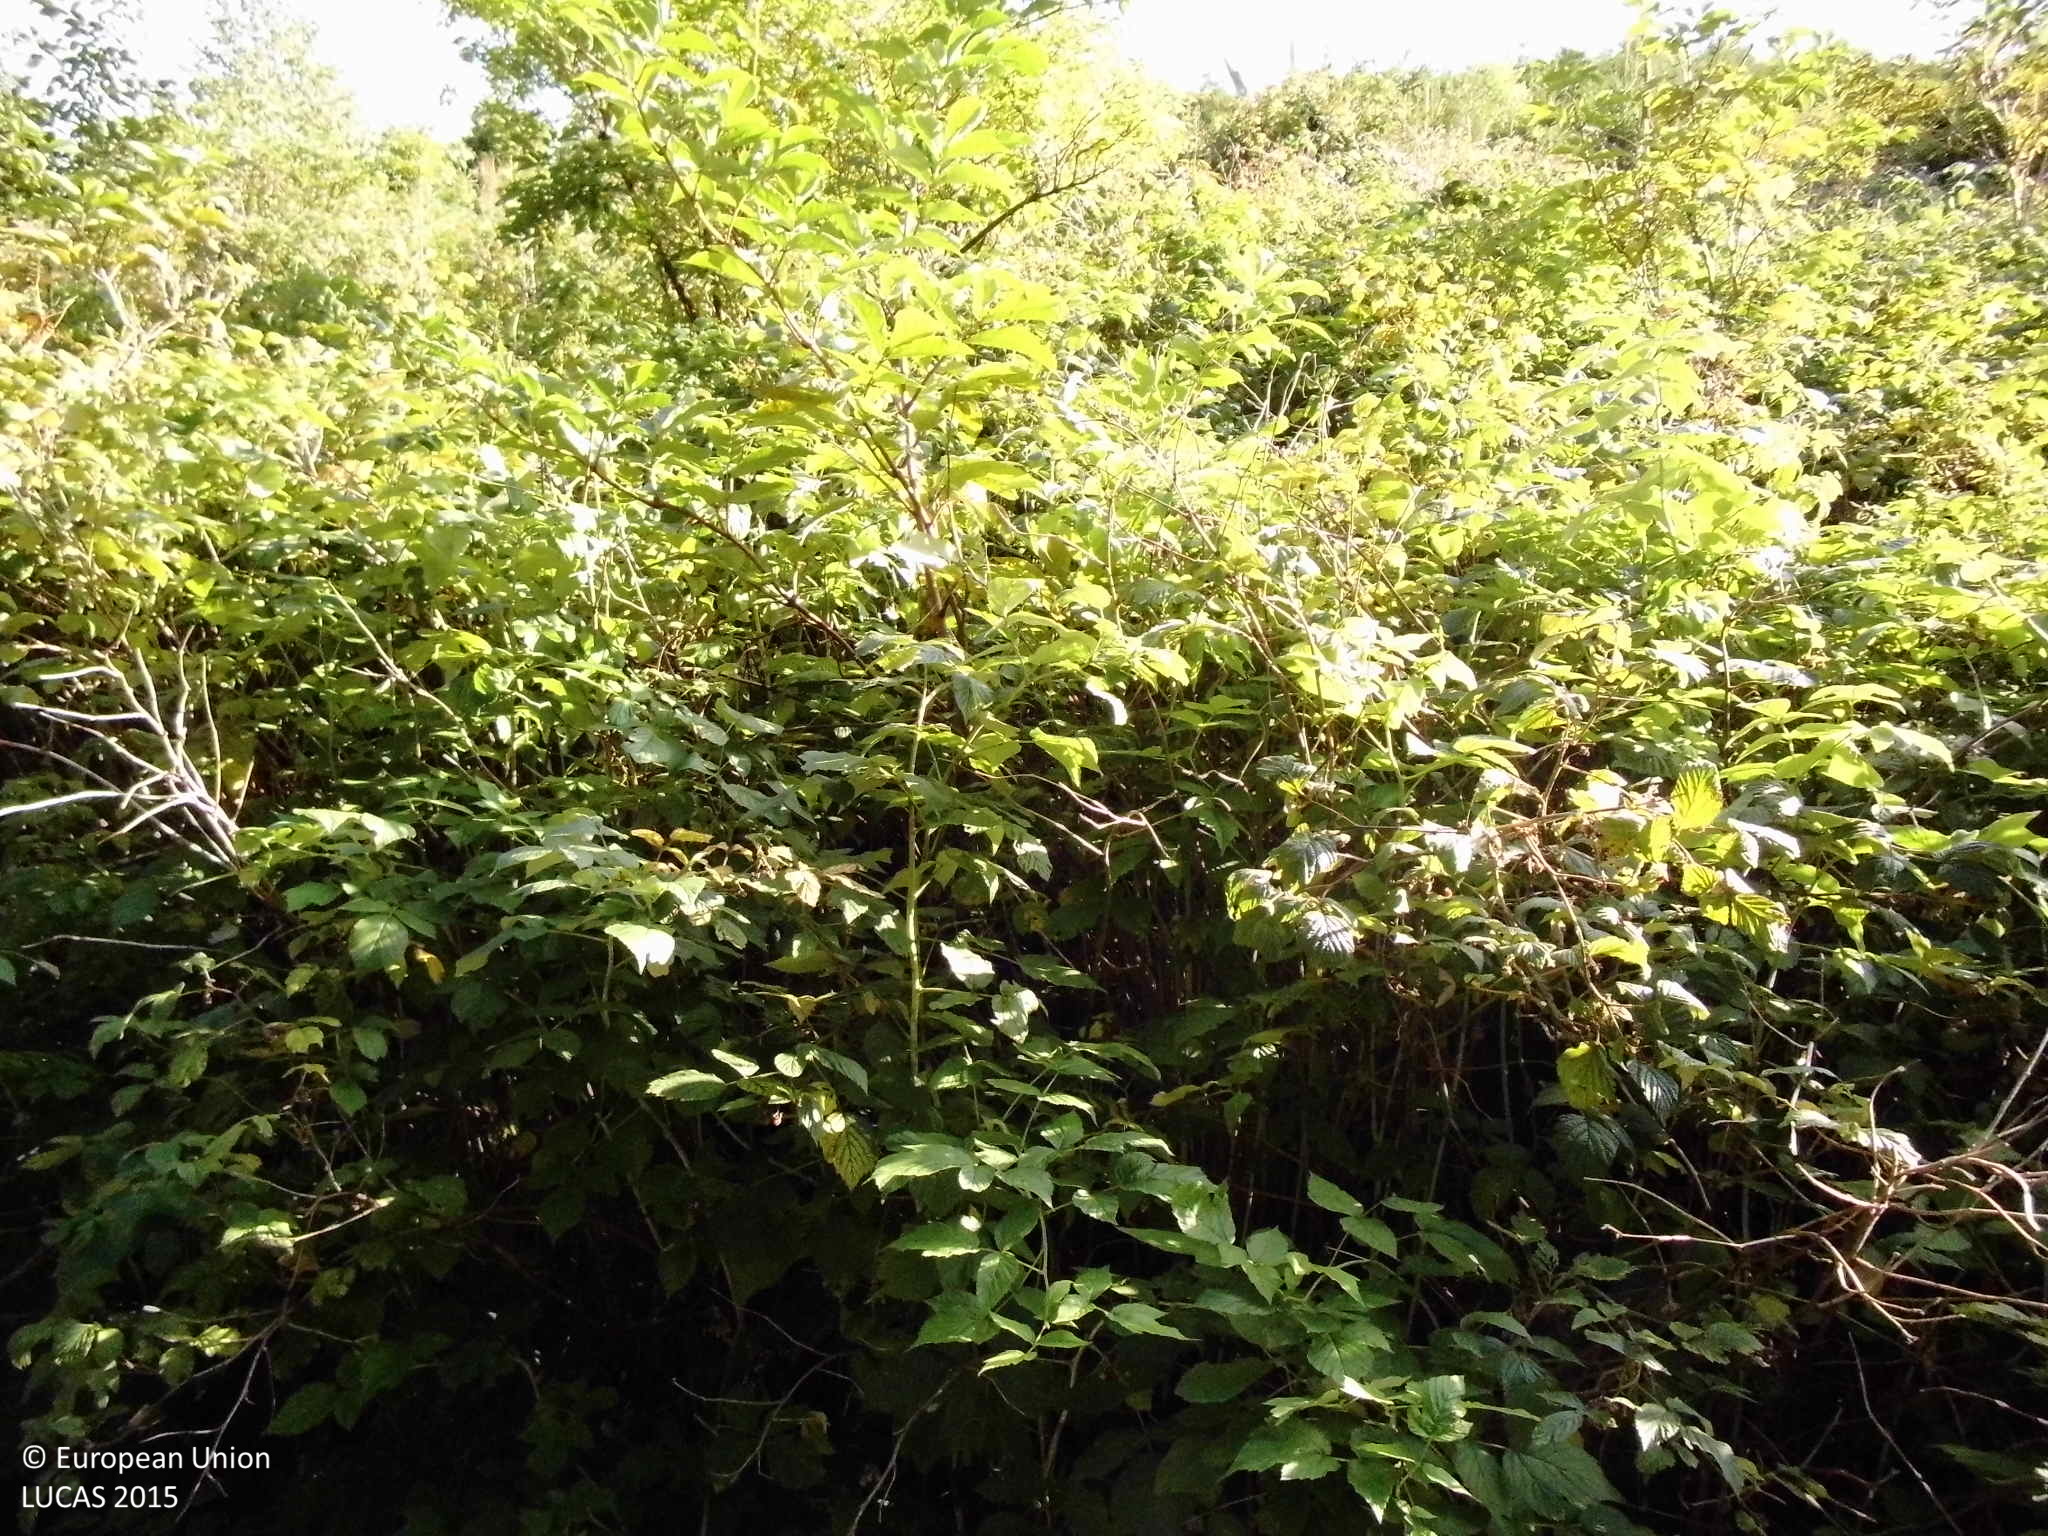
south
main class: Woodland
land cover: Spruce dominated mixed woodland
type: hemiboreal forest and nemoral coniferous forest and mixed broadleaved-coniferous forest
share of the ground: 25 - 50 %
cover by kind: shrubs 50 %, coniferous forest trees 35 %, broadleaved forest trees 15 %
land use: Forestry
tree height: < 5 m
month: September
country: DE
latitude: 51.3083
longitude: 8.5802
